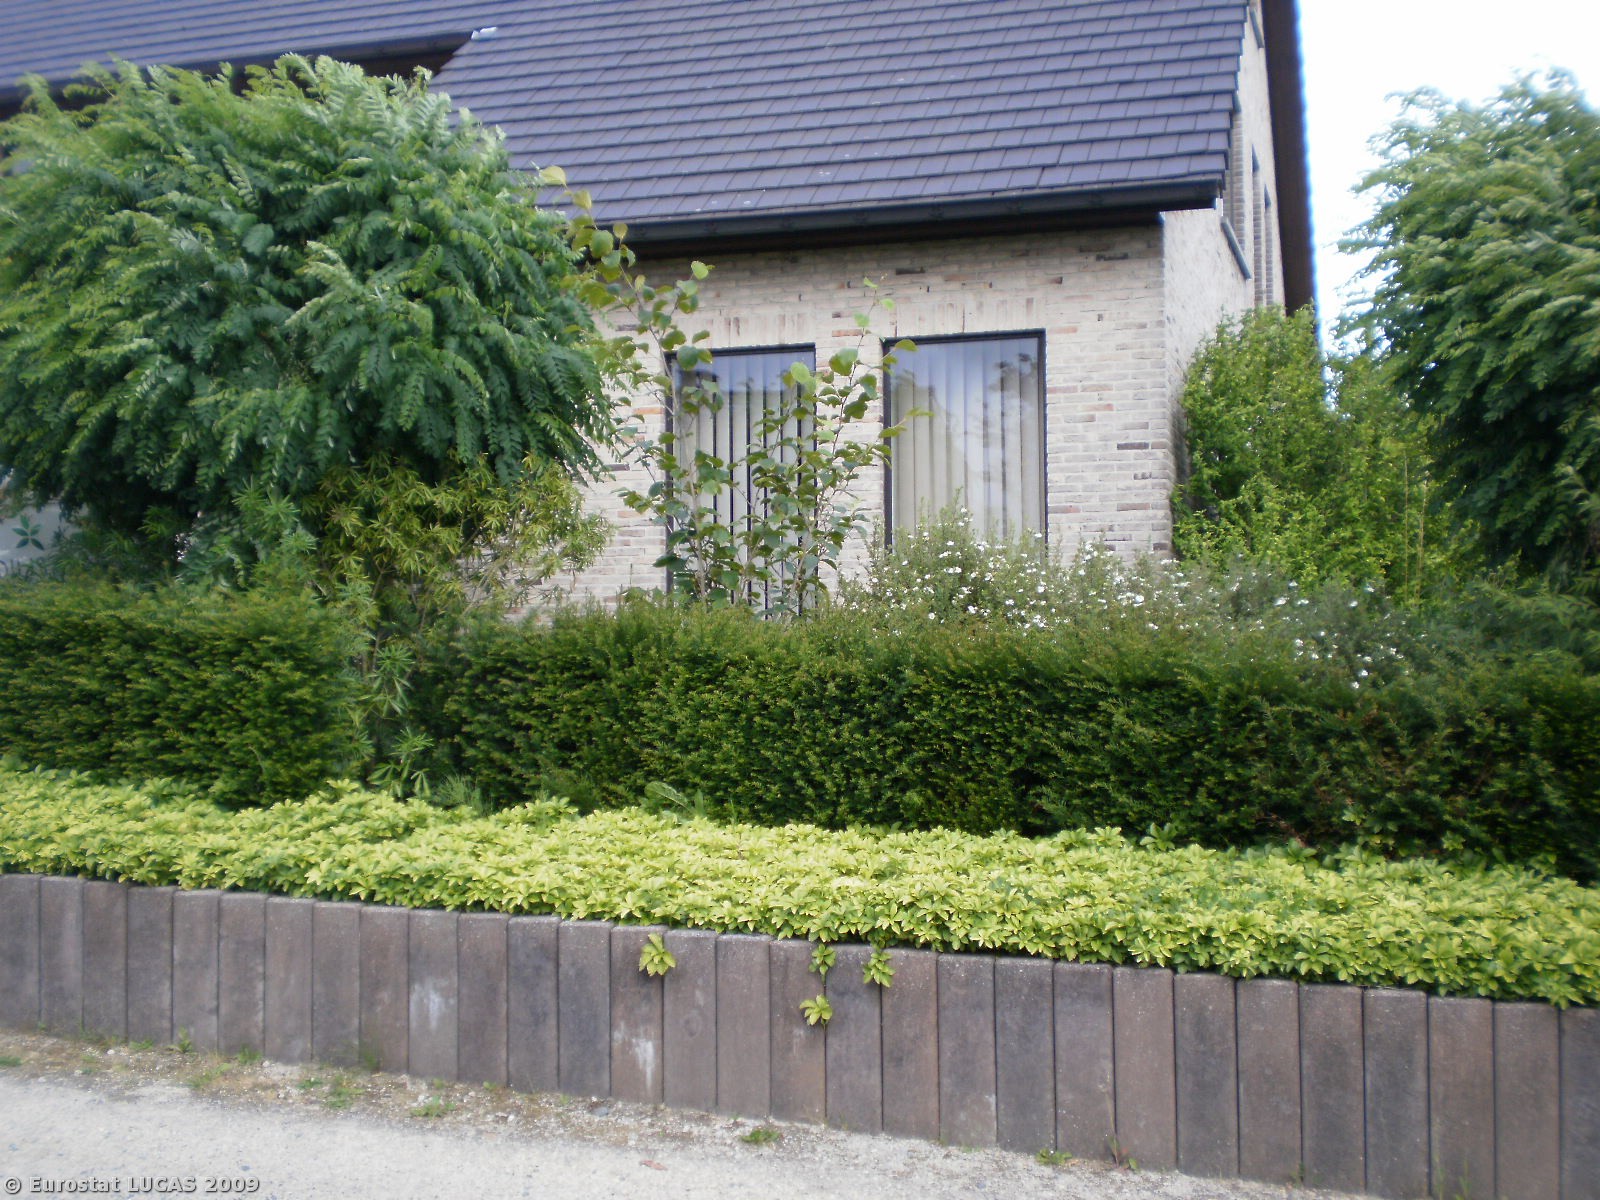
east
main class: Artificial land
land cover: Non built-up linear features
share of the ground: 25 - 50 %
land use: Residential
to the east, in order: Non built-up linear features; Floriculture and ornamental plants; Artificial constructions in urban areas; Fences; Grassland with sparse tree/shrub cover; Fences; Artificial constructions in urban areas
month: July
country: BE
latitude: 50.8858
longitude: 4.2380
